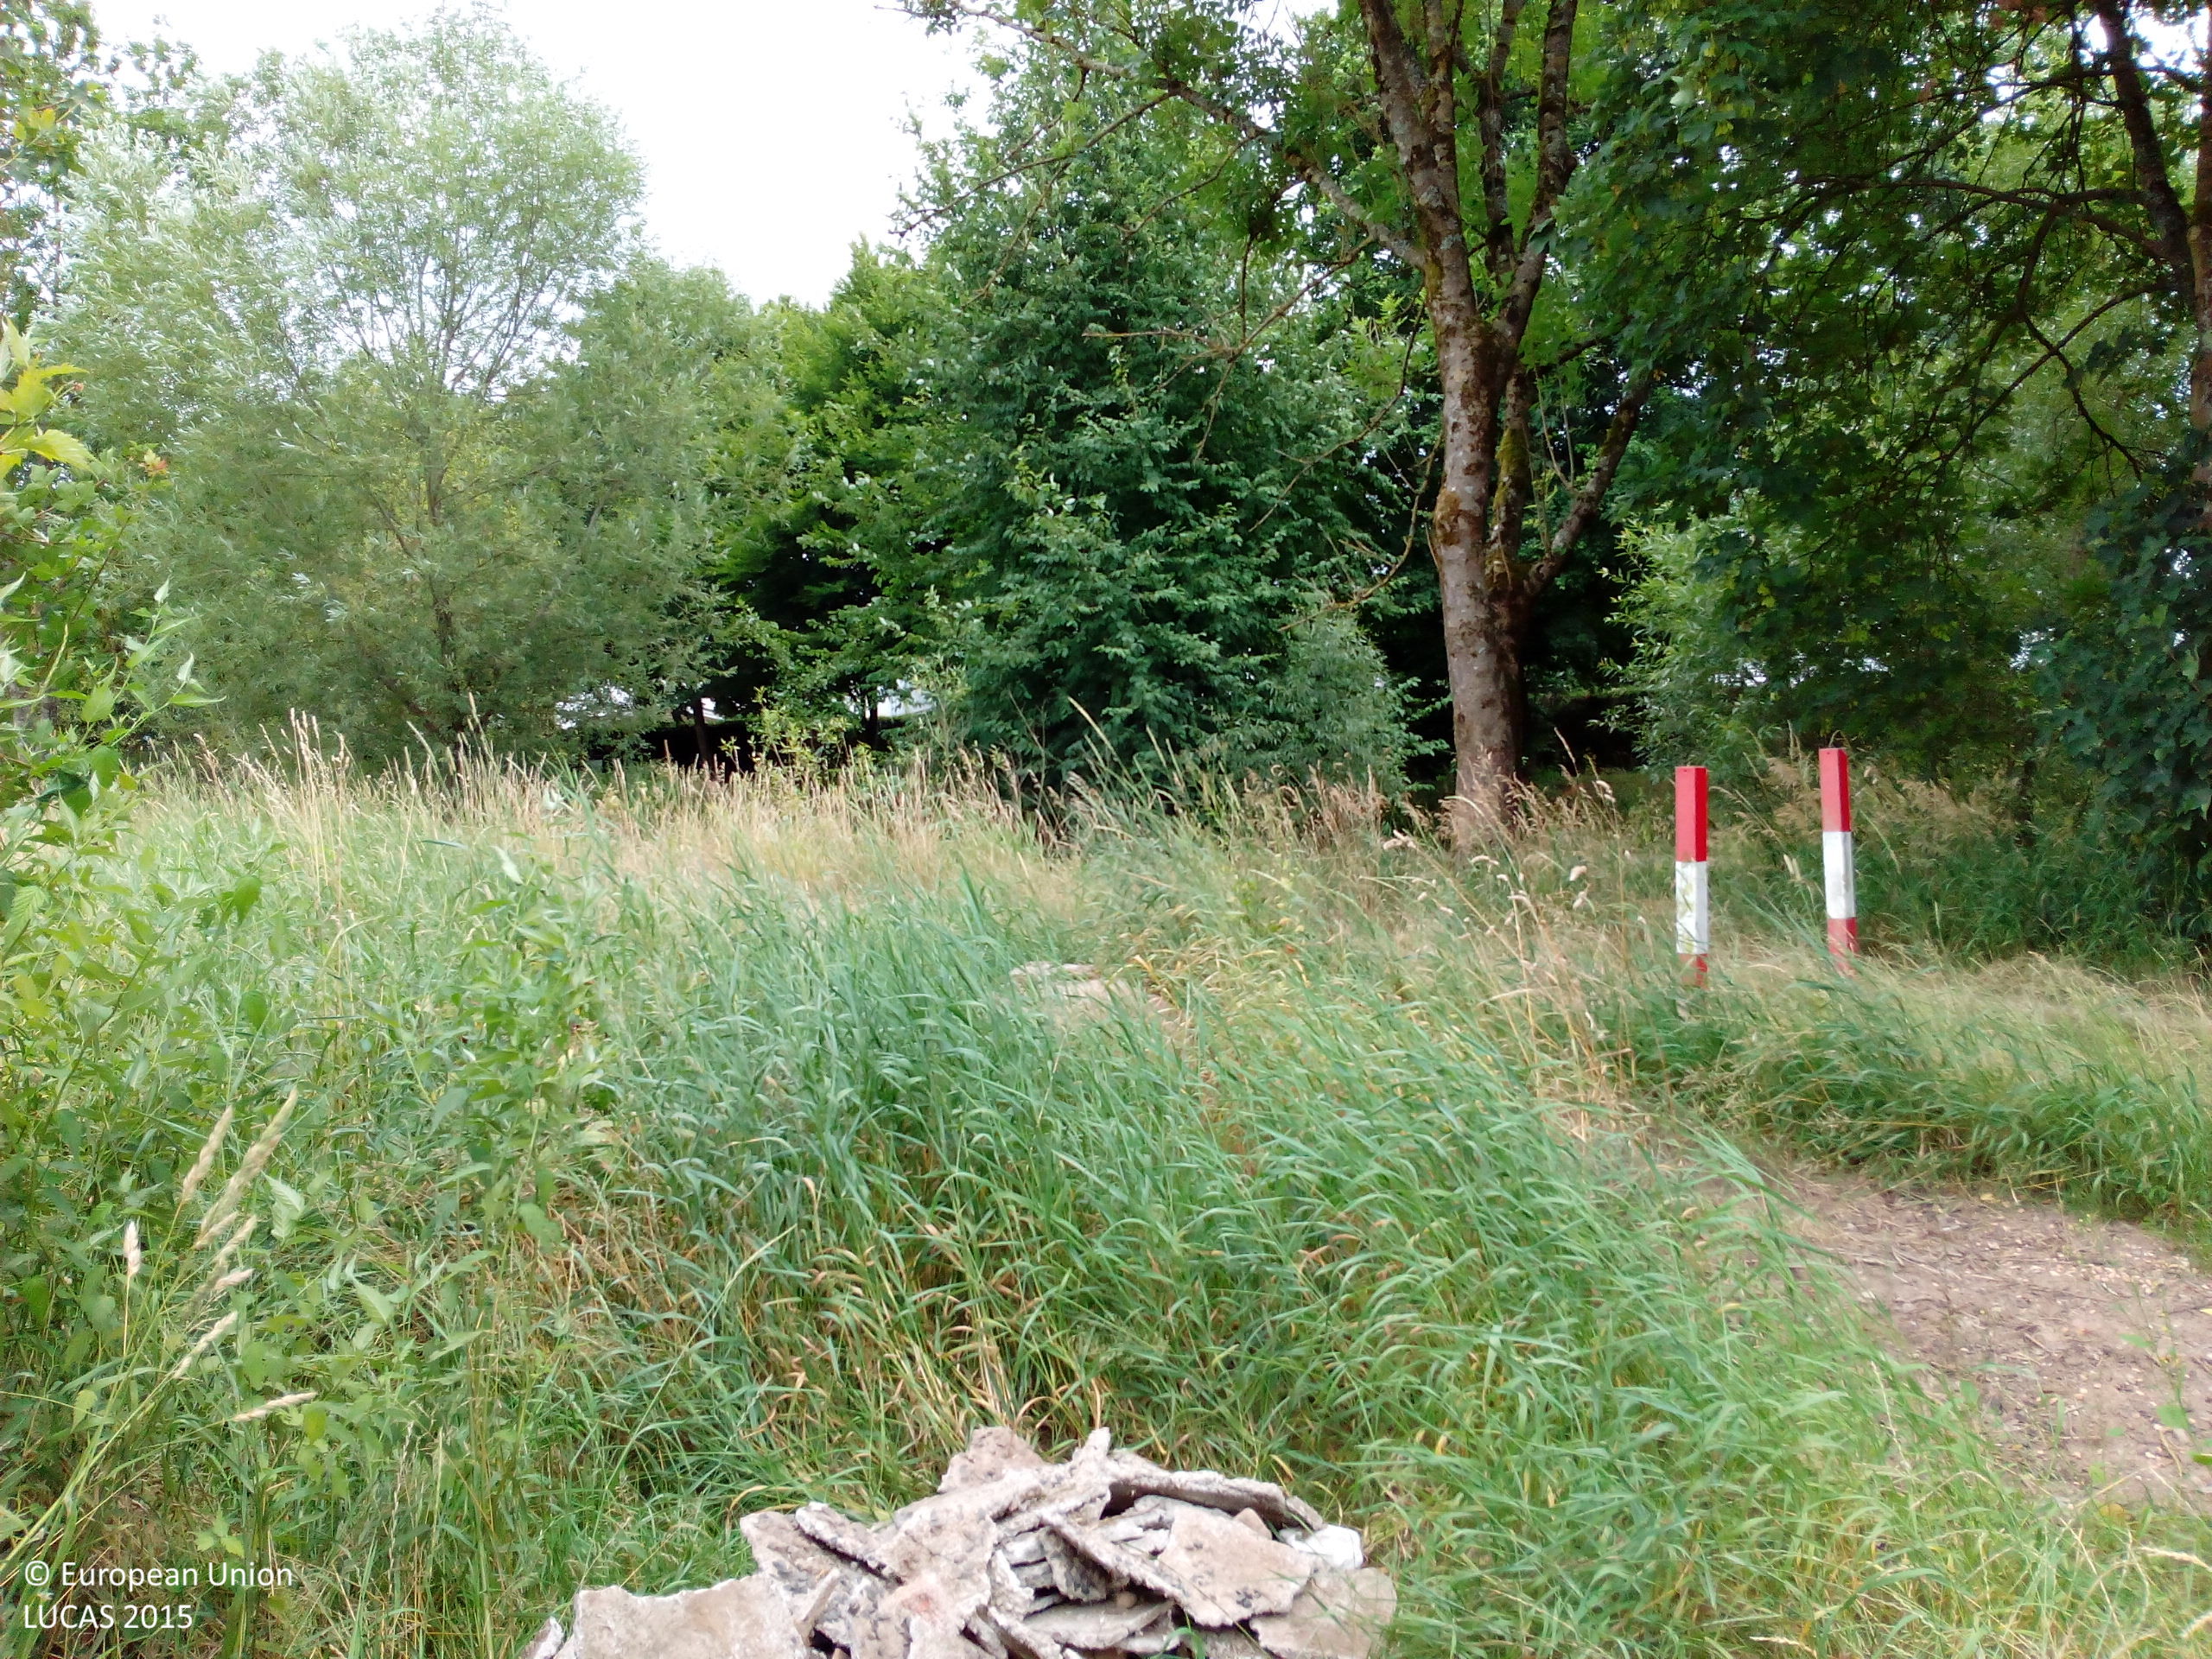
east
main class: Grassland
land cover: Grassland without tree/shrub cover
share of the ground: > 75 %
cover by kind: herbaceous plants 85 %, unconsolidated bare surface 15 %
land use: Kitchen garden
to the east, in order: Spontaneously vegetated surfaces; Artificial constructions in urban areas; Shruby margins; Inland fresh running water; Shruby margins; Tracks; Broadleaved woodland; Artificial constructions in urban areas
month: July
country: DE
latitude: 47.6414
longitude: 7.6987
